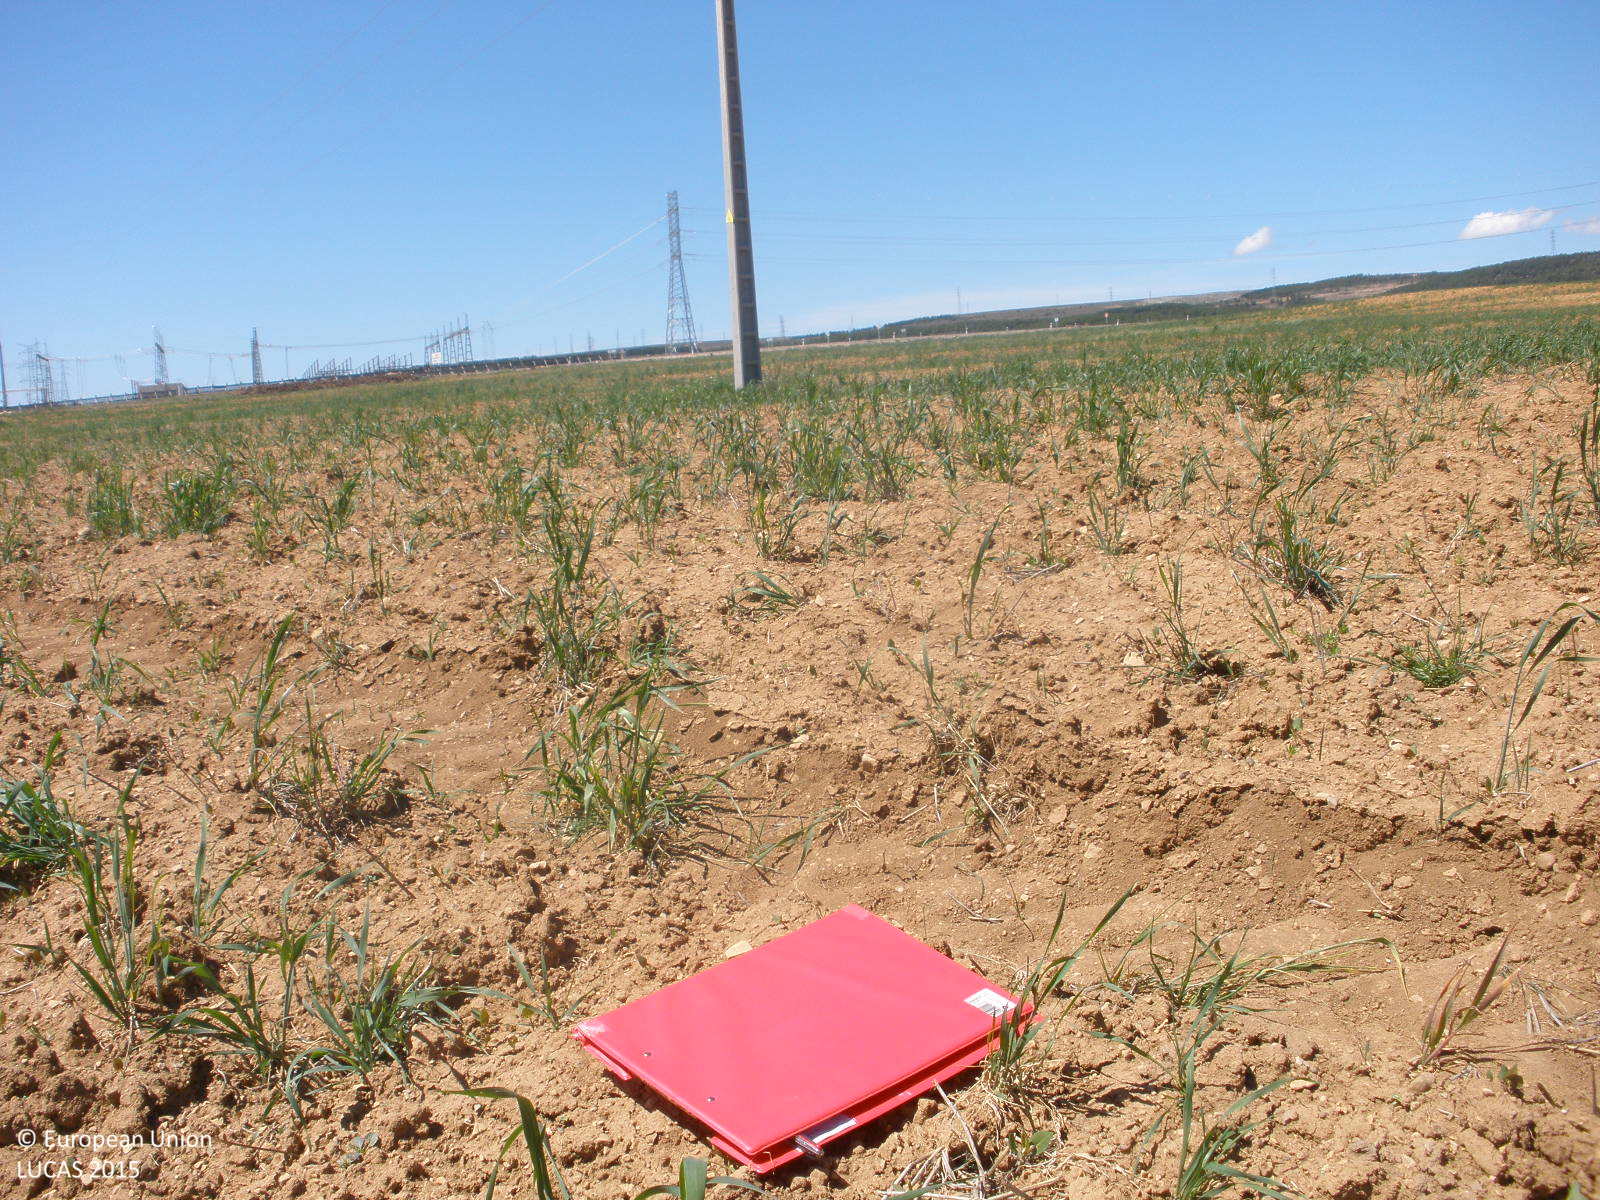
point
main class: Grassland
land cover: Spontaneously vegetated surfaces
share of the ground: 25 - 50 %
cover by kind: herbaceous plants 50 %, unconsolidated bare surface 50 %
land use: Fallow land
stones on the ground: < 10 %
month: May
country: ES
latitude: 40.7219
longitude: -0.8452
